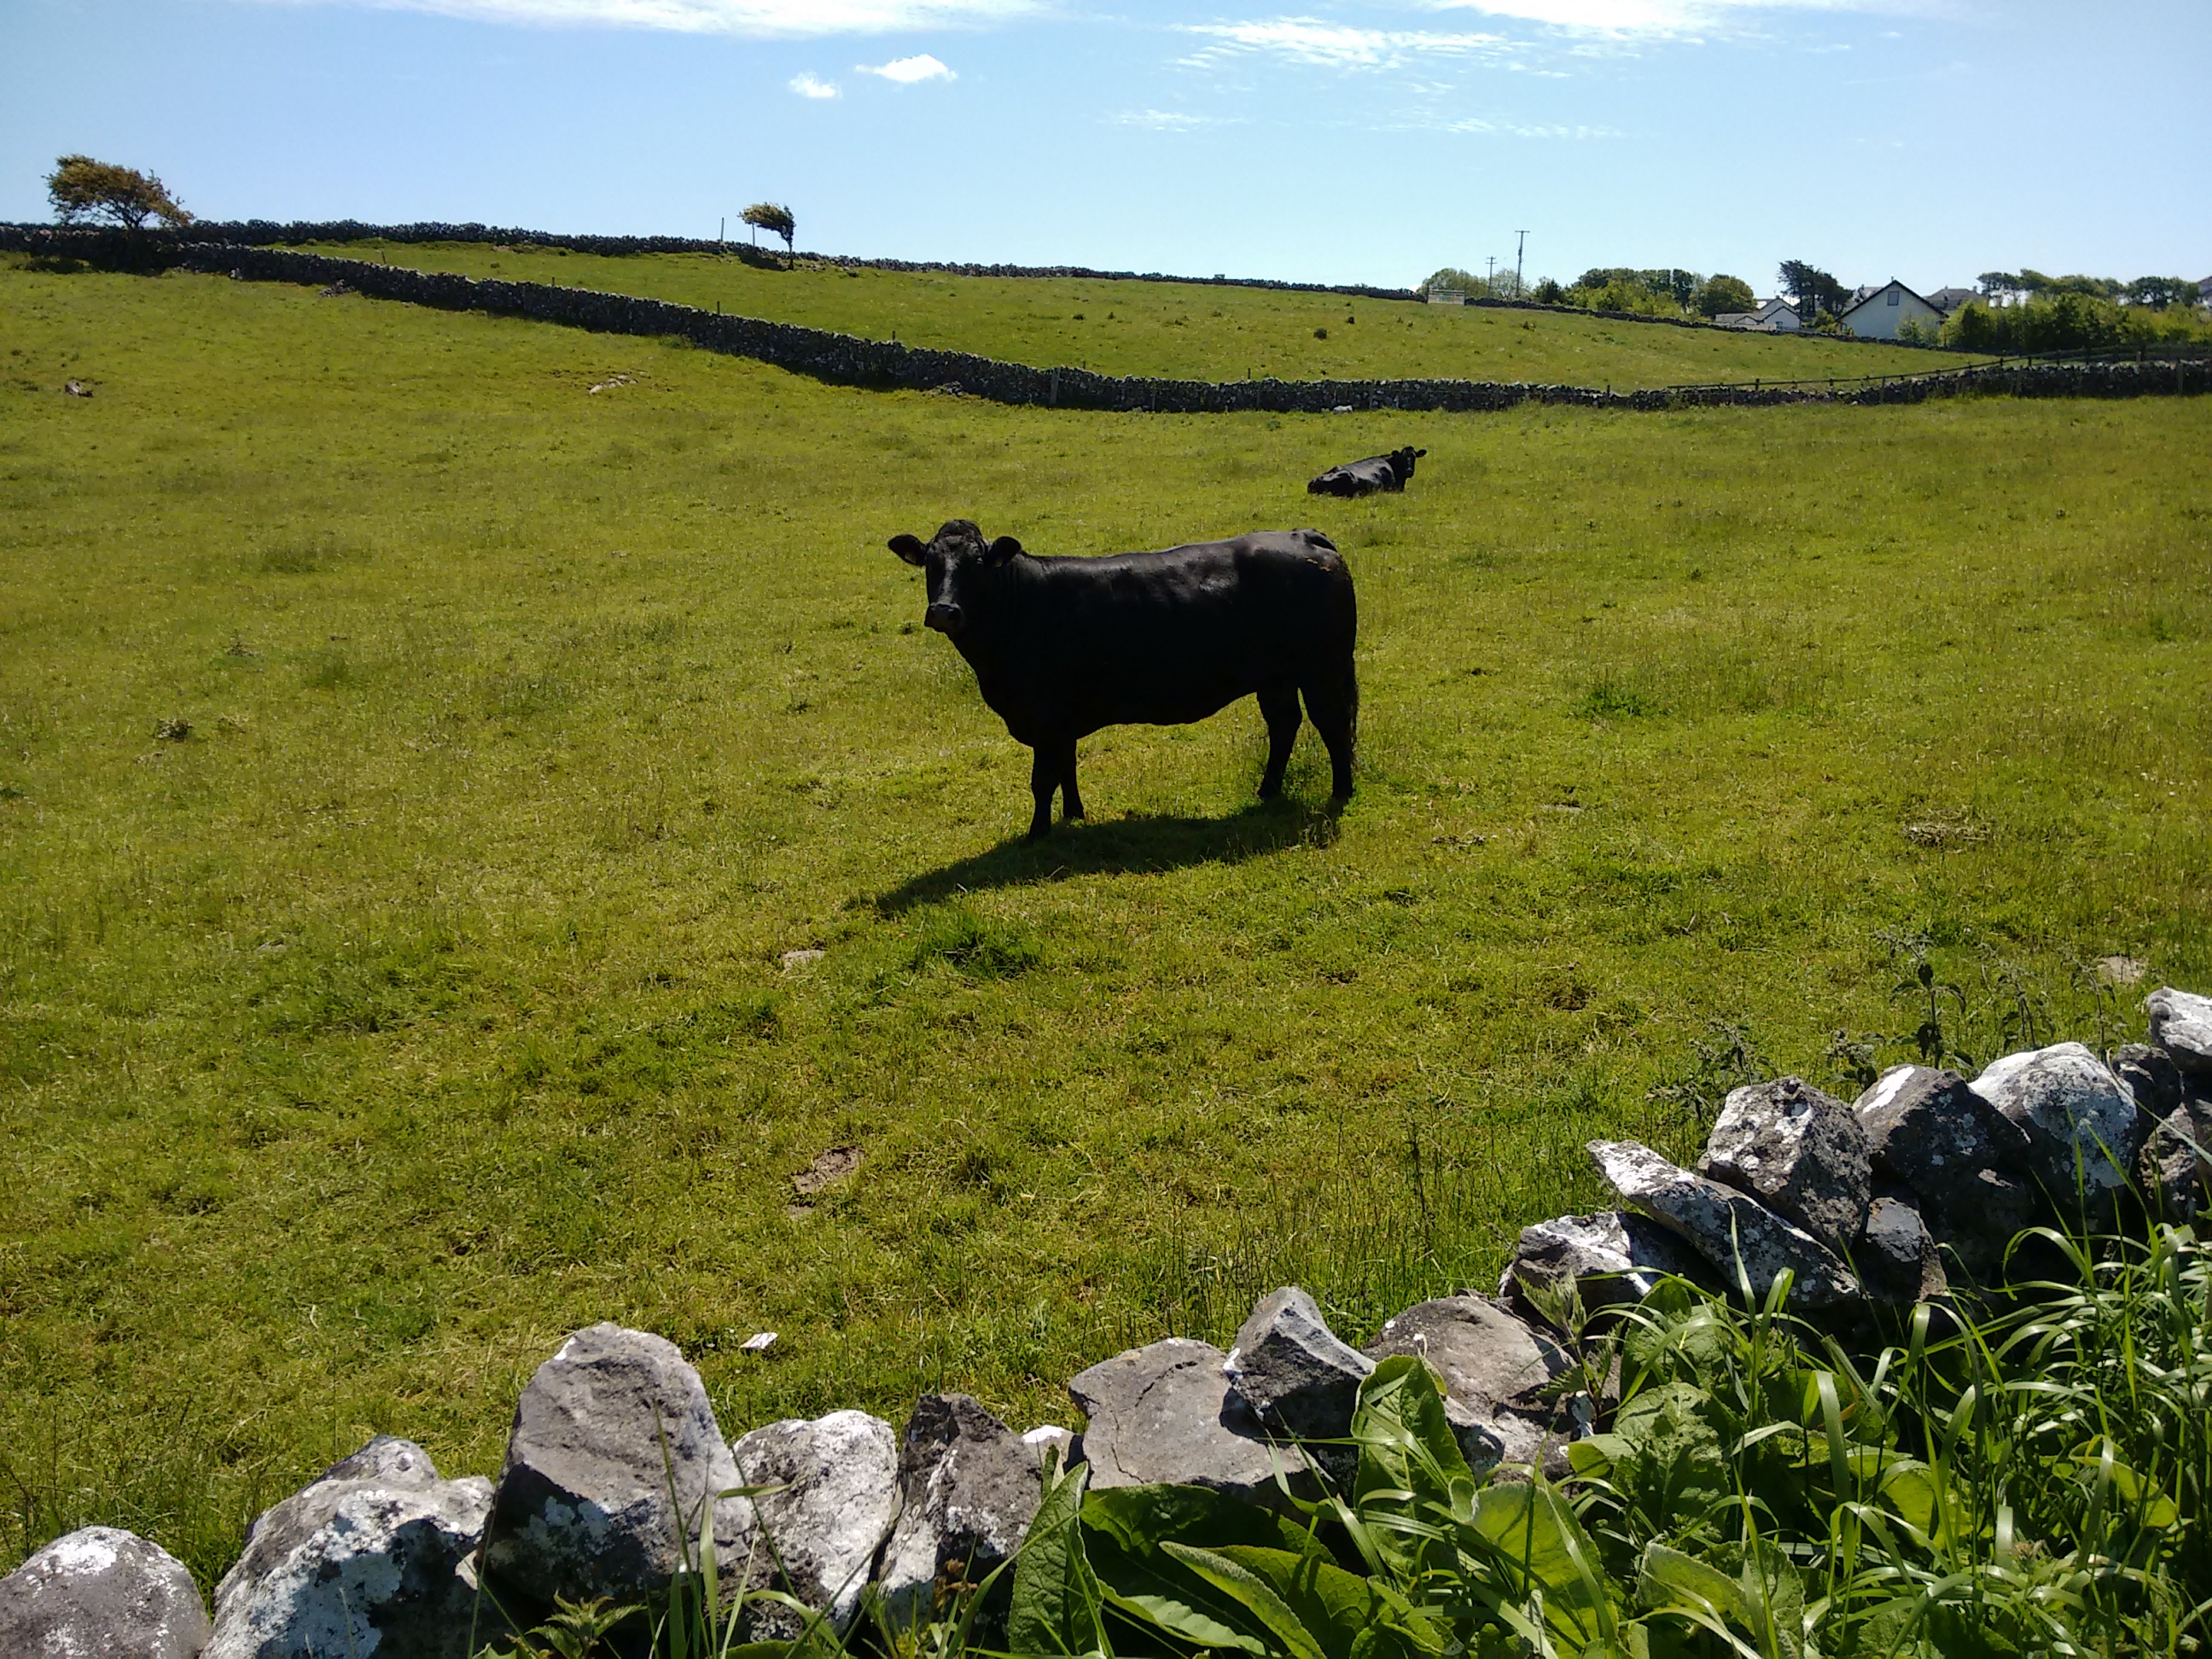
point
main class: Grassland
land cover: Grassland without tree/shrub cover
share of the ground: > 75 %
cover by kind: herbaceous plants 100 %
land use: Agriculture (excluding fallow land and kitchen gardens)
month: June
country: IE
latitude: 53.2178
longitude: -8.9457
